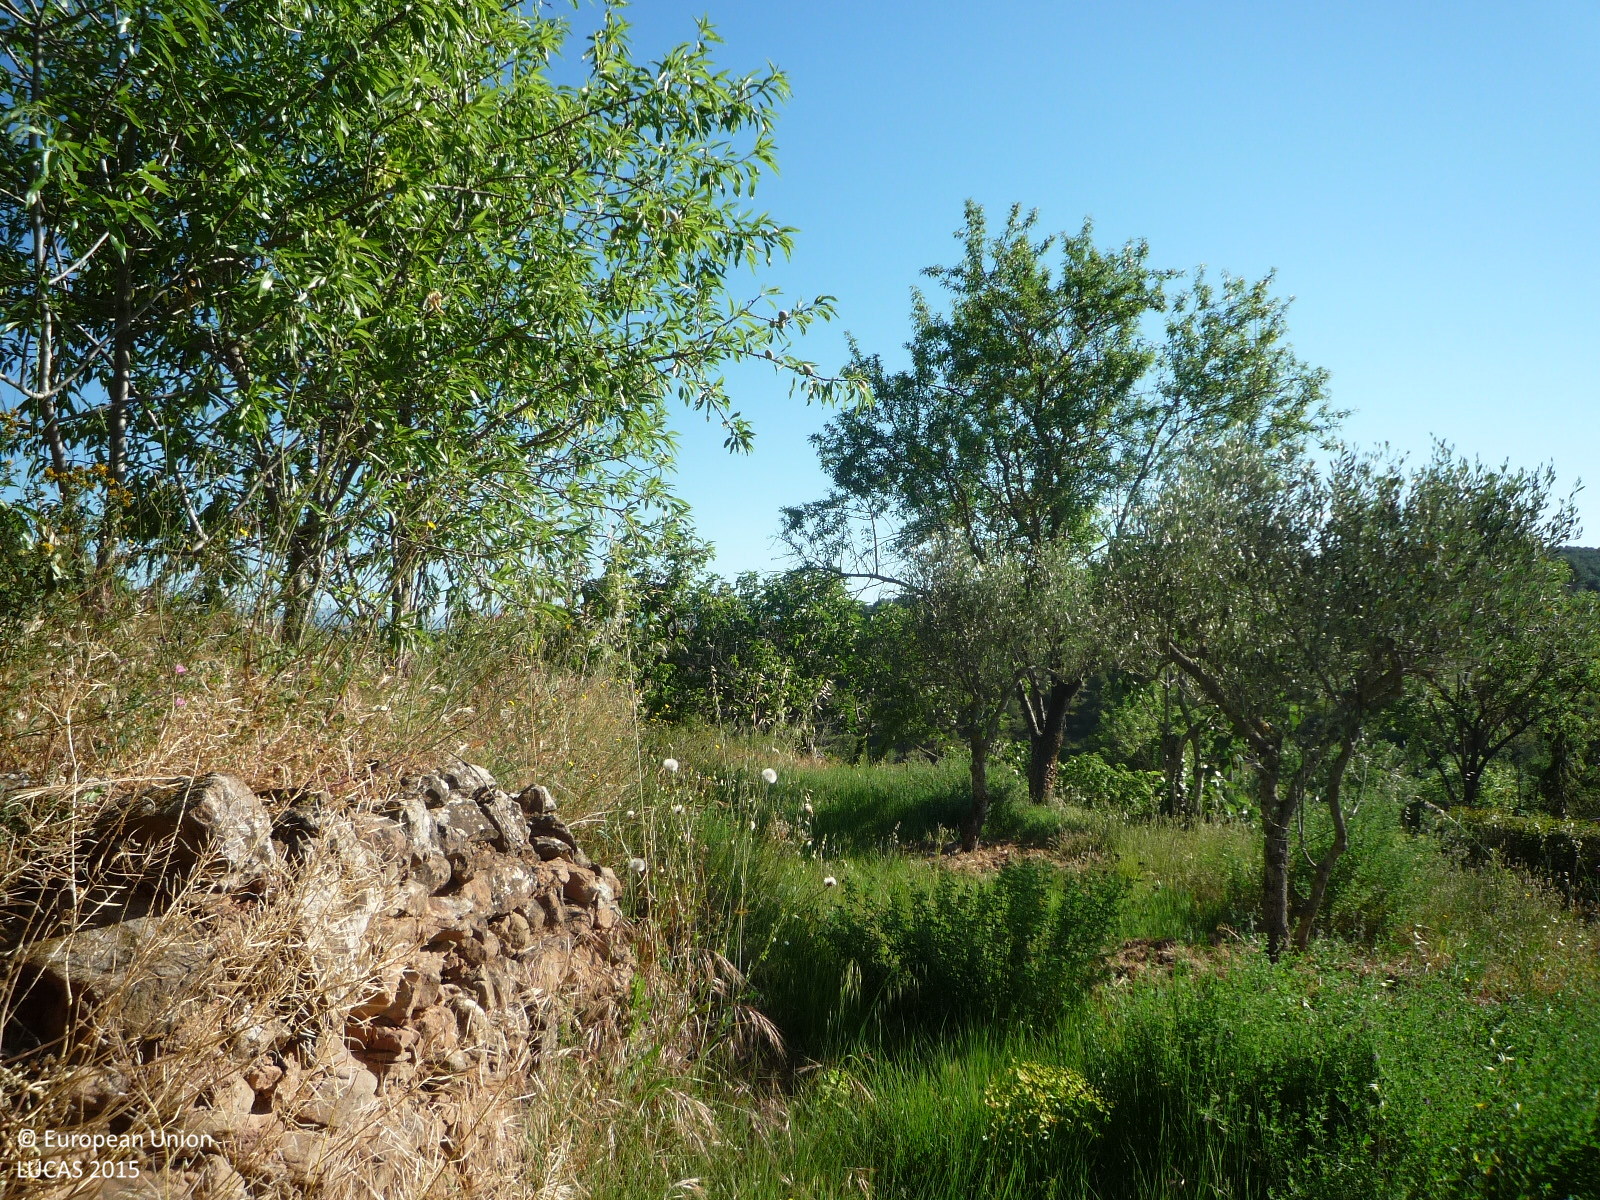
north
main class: Shrubland
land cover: Shrubland with sparse tree cover
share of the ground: 50 - 75 %
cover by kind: shrubs 60 %, herbaceous plants 35 %, broadleaved forest trees 5 %
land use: Semi-natural and natural areas not in use
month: May
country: ES
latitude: 41.8922
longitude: 1.6613
